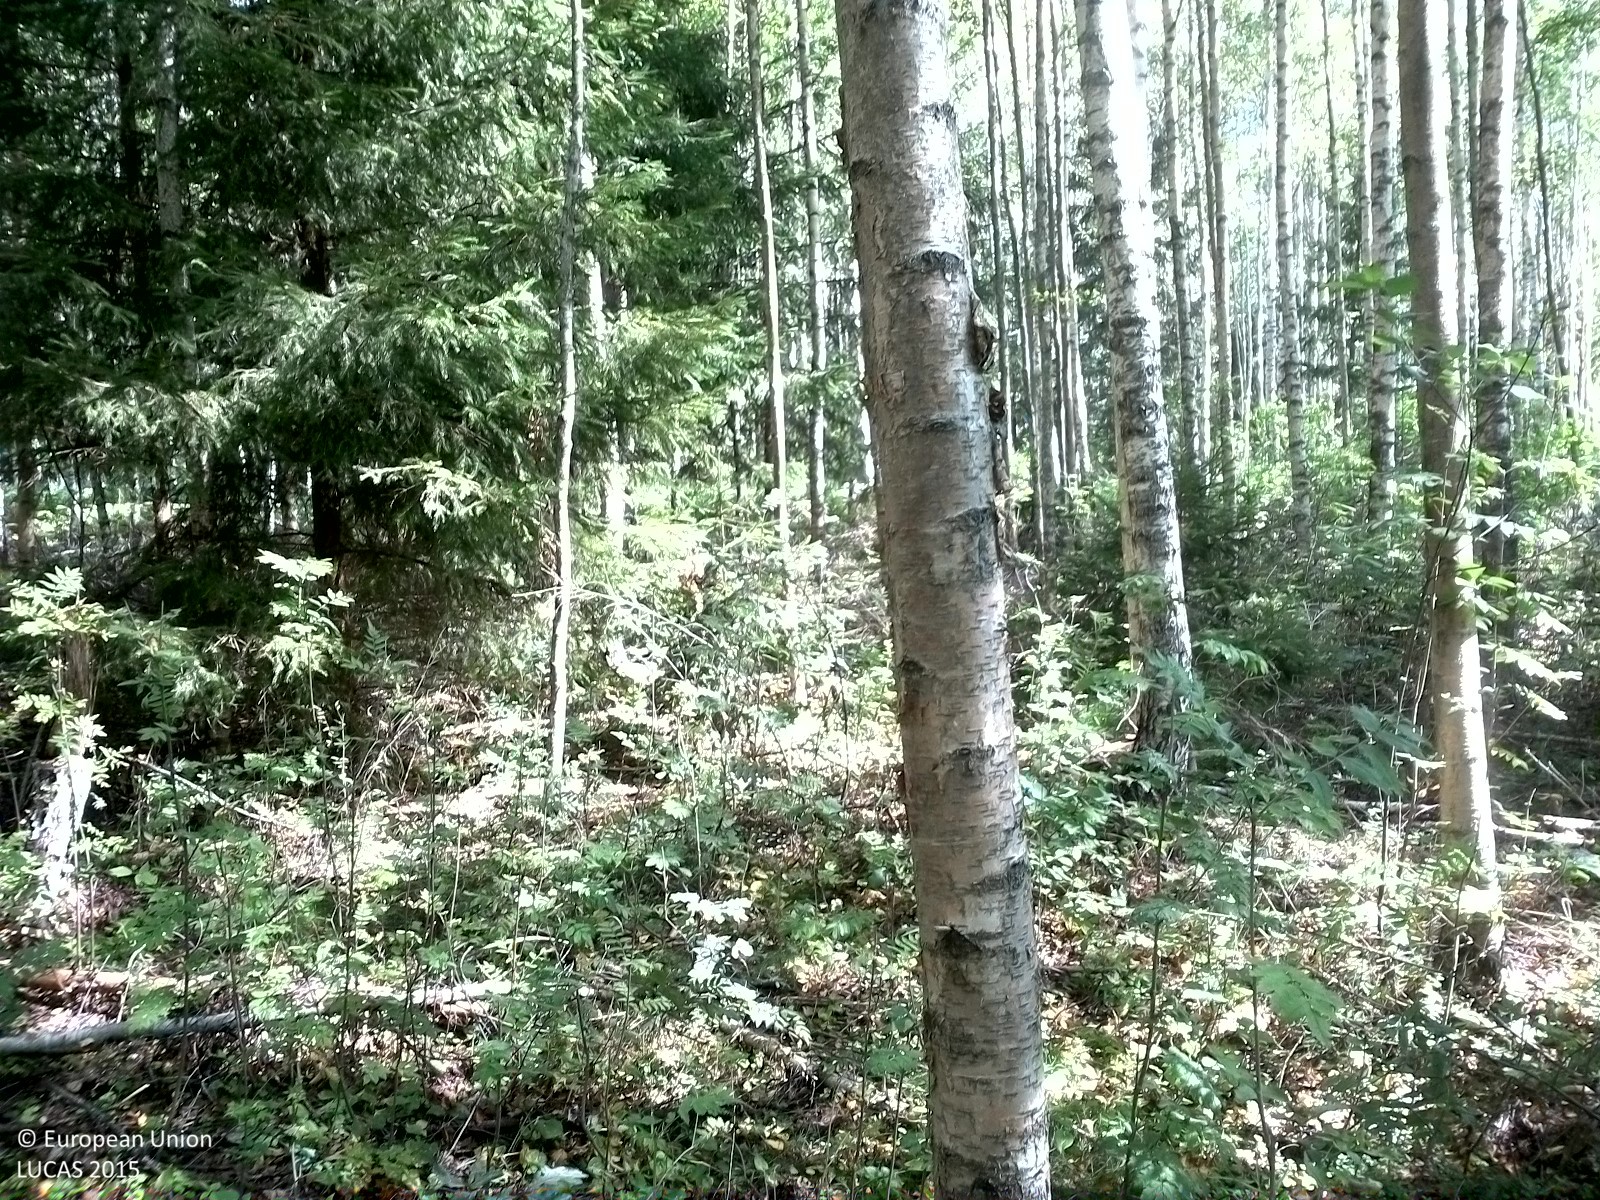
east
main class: Woodland
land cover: Spruce dominated mixed woodland
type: boreal forest
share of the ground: 25 - 50 %
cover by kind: coniferous forest trees 25 %, herbaceous plants 25 %, broadleaved forest trees 20 %, unconsolidated bare surface 20 %, shrubs 5 %, lichens and mosses 5 %
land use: Forestry
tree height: > 5 m
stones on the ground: < 10 %
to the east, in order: Spruce dominated mixed woodland; Broadleaved woodland; Spruce dominated mixed woodland; Electric lines; Spruce dominated mixed woodland; Broadleaved woodland
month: August
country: SE
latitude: 59.2428
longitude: 15.5142
